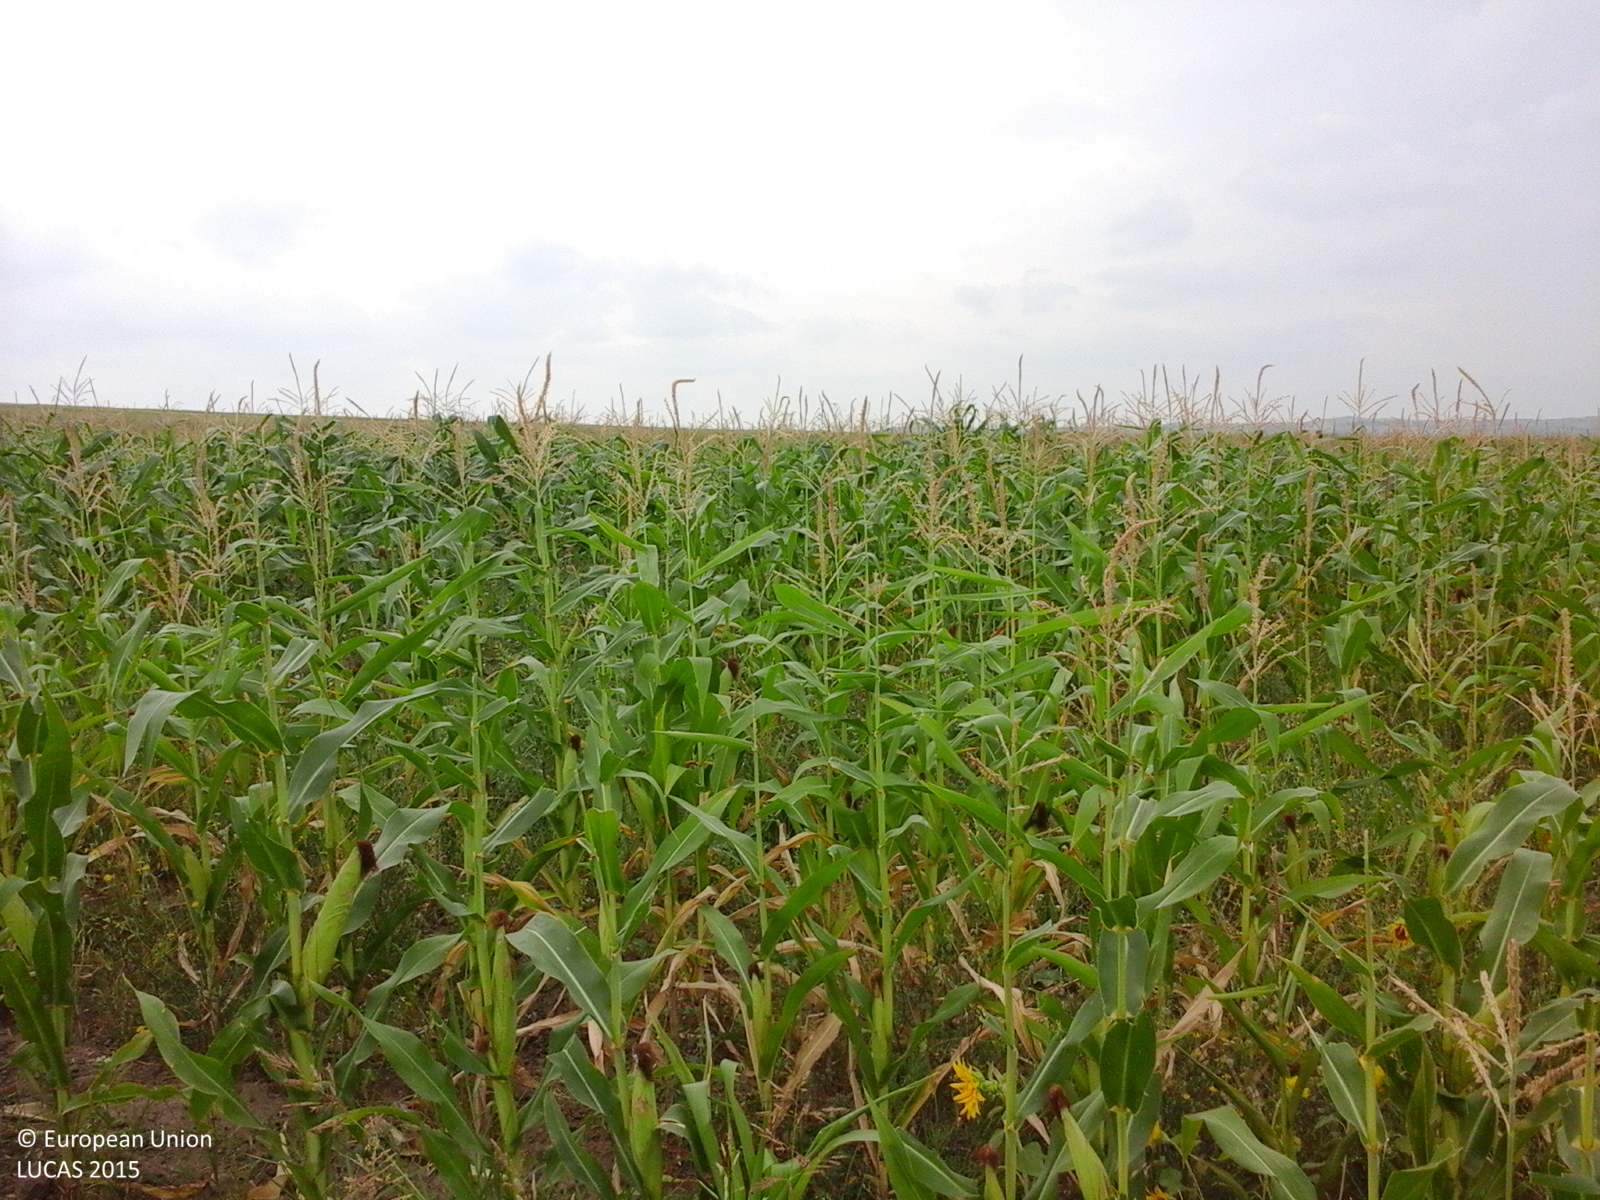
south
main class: Cropland
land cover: Maize
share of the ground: > 75 %
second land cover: Spontaneously vegetated surfaces
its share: > 75 %
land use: Agriculture (excluding fallow land and kitchen gardens)
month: July
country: RO
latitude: 44.9382
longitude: 28.2019
